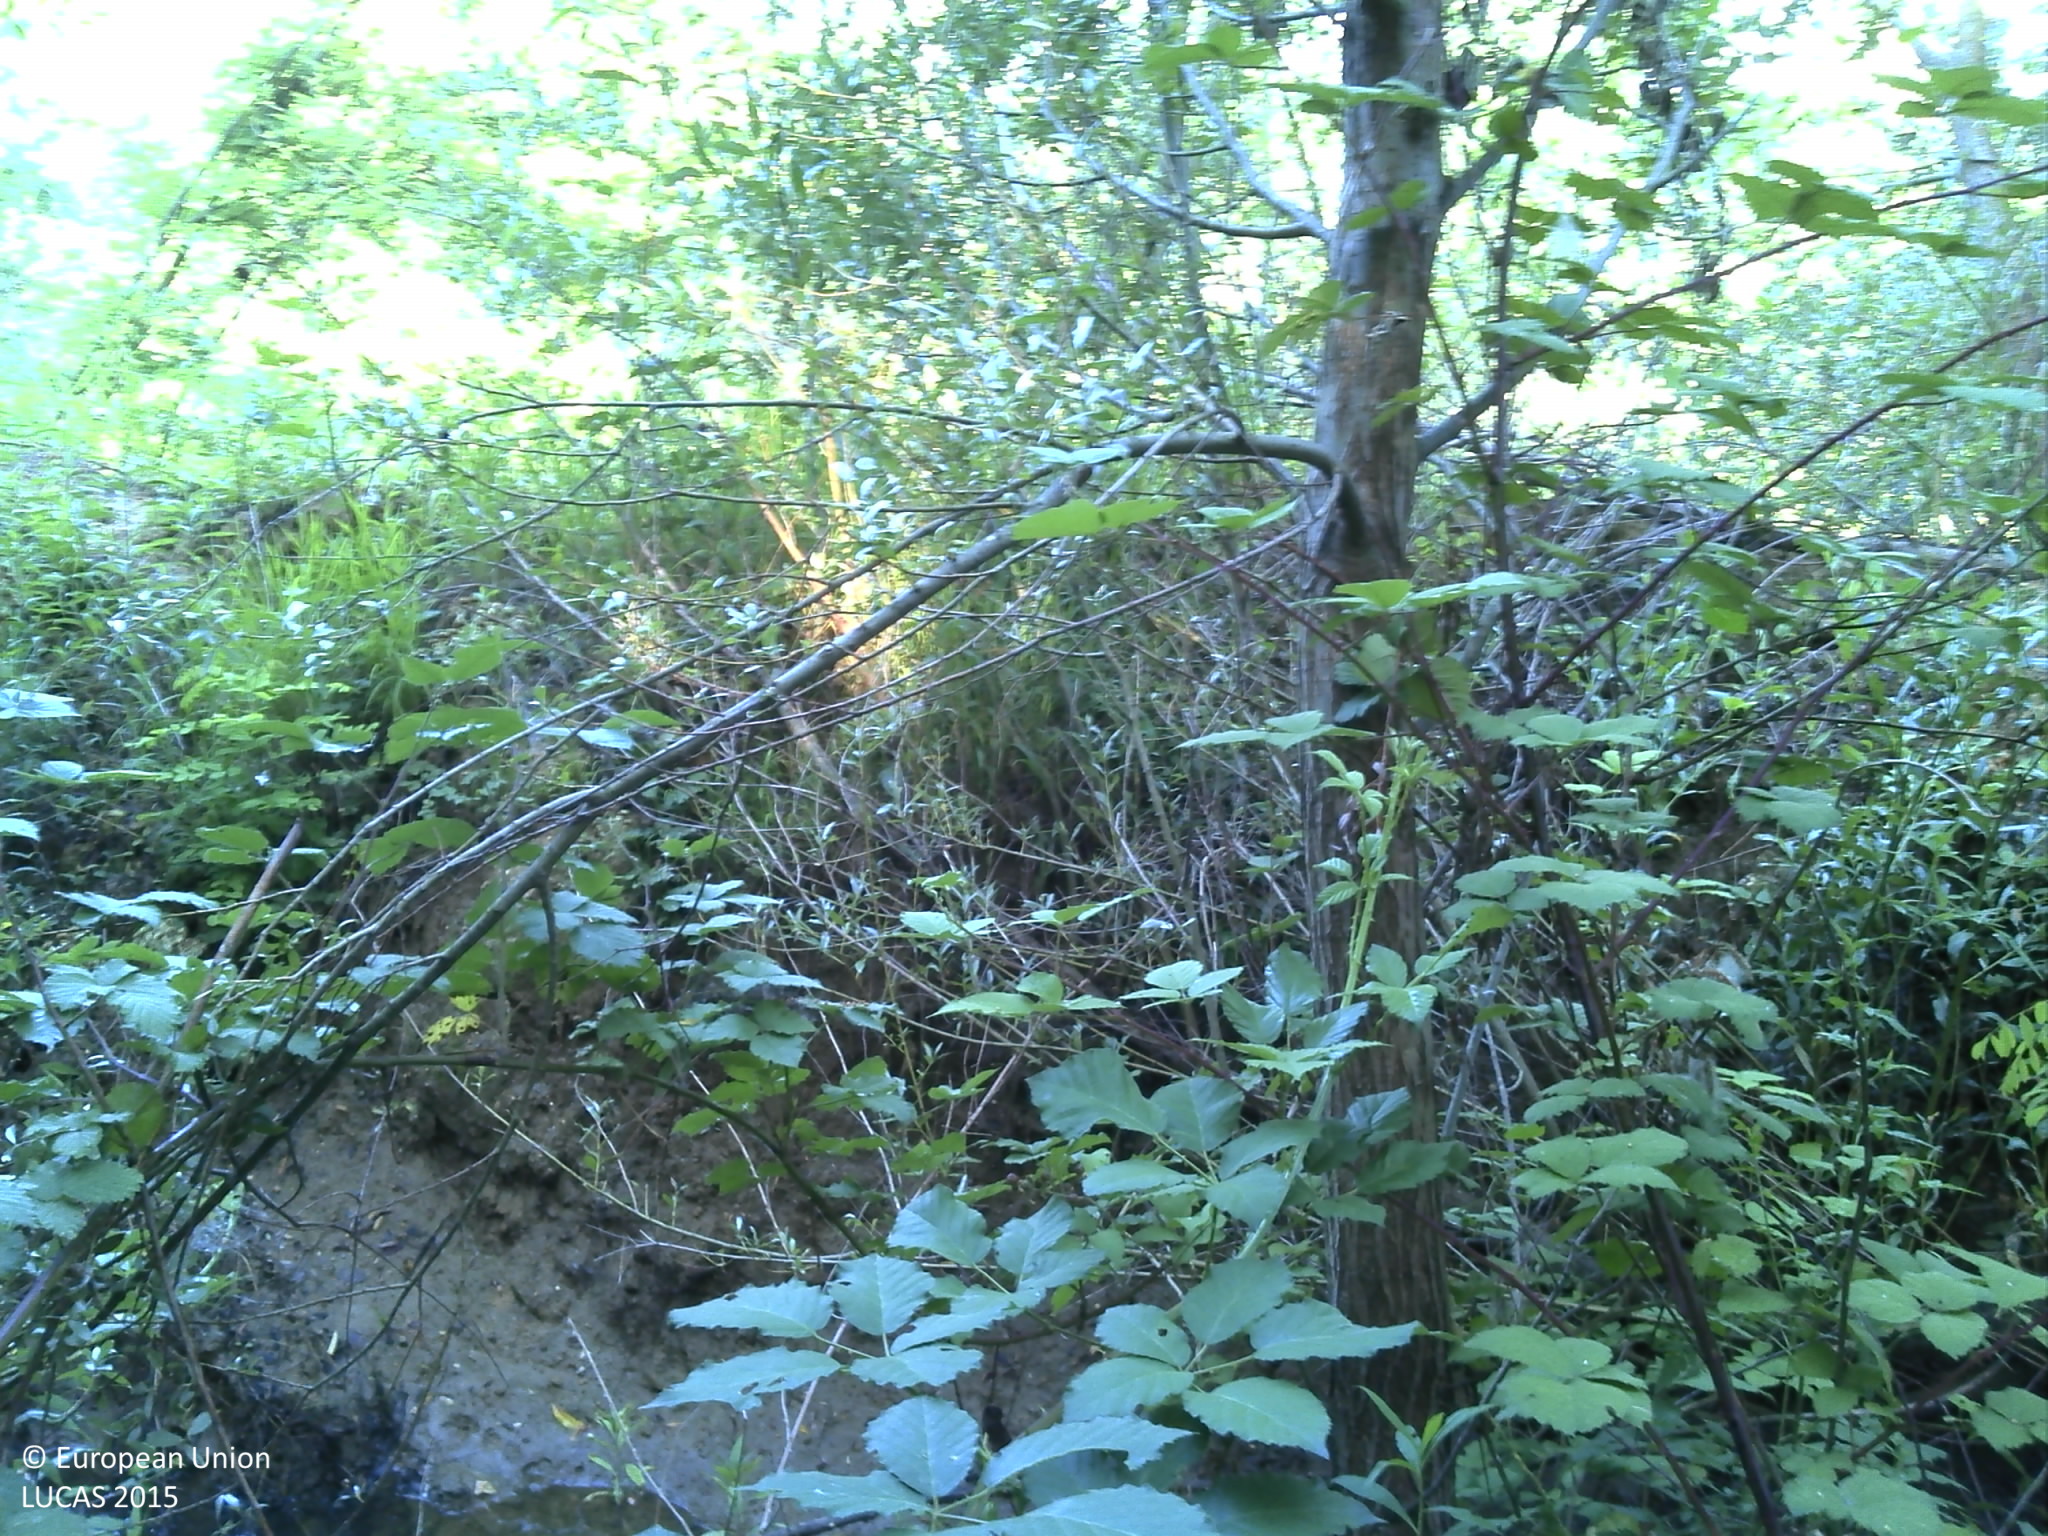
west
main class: Woodland
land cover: Broadleaved woodland
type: acidophilous oak and oak-birch forest
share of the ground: > 75 %
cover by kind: broadleaved forest trees 90 %, shrubs 10 %
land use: Forestry
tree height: < 5 m
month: June
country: HR
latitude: 45.8303
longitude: 17.3010
